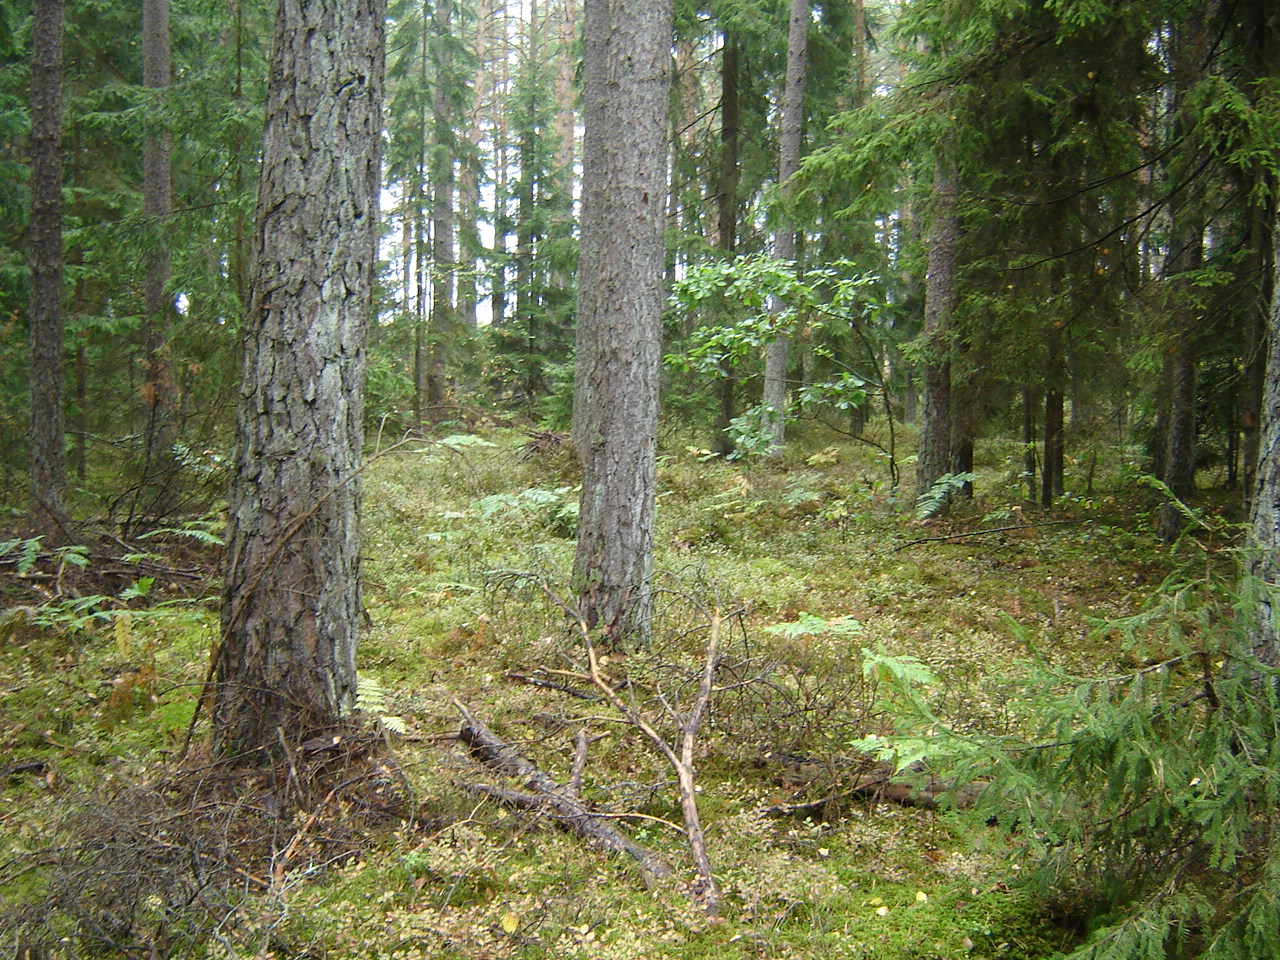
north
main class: Woodland
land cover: Pine dominated coniferous woodland
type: hemiboreal forest and nemoral coniferous forest and mixed broadleaved-coniferous forest
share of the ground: > 75 %
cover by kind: coniferous forest trees 75 %, shrubs 15 %, broadleaved forest trees 5 %, lichens and mosses 5 %
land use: Forestry
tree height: > 5 m
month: September
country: LT
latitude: 54.2713
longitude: 24.7117
